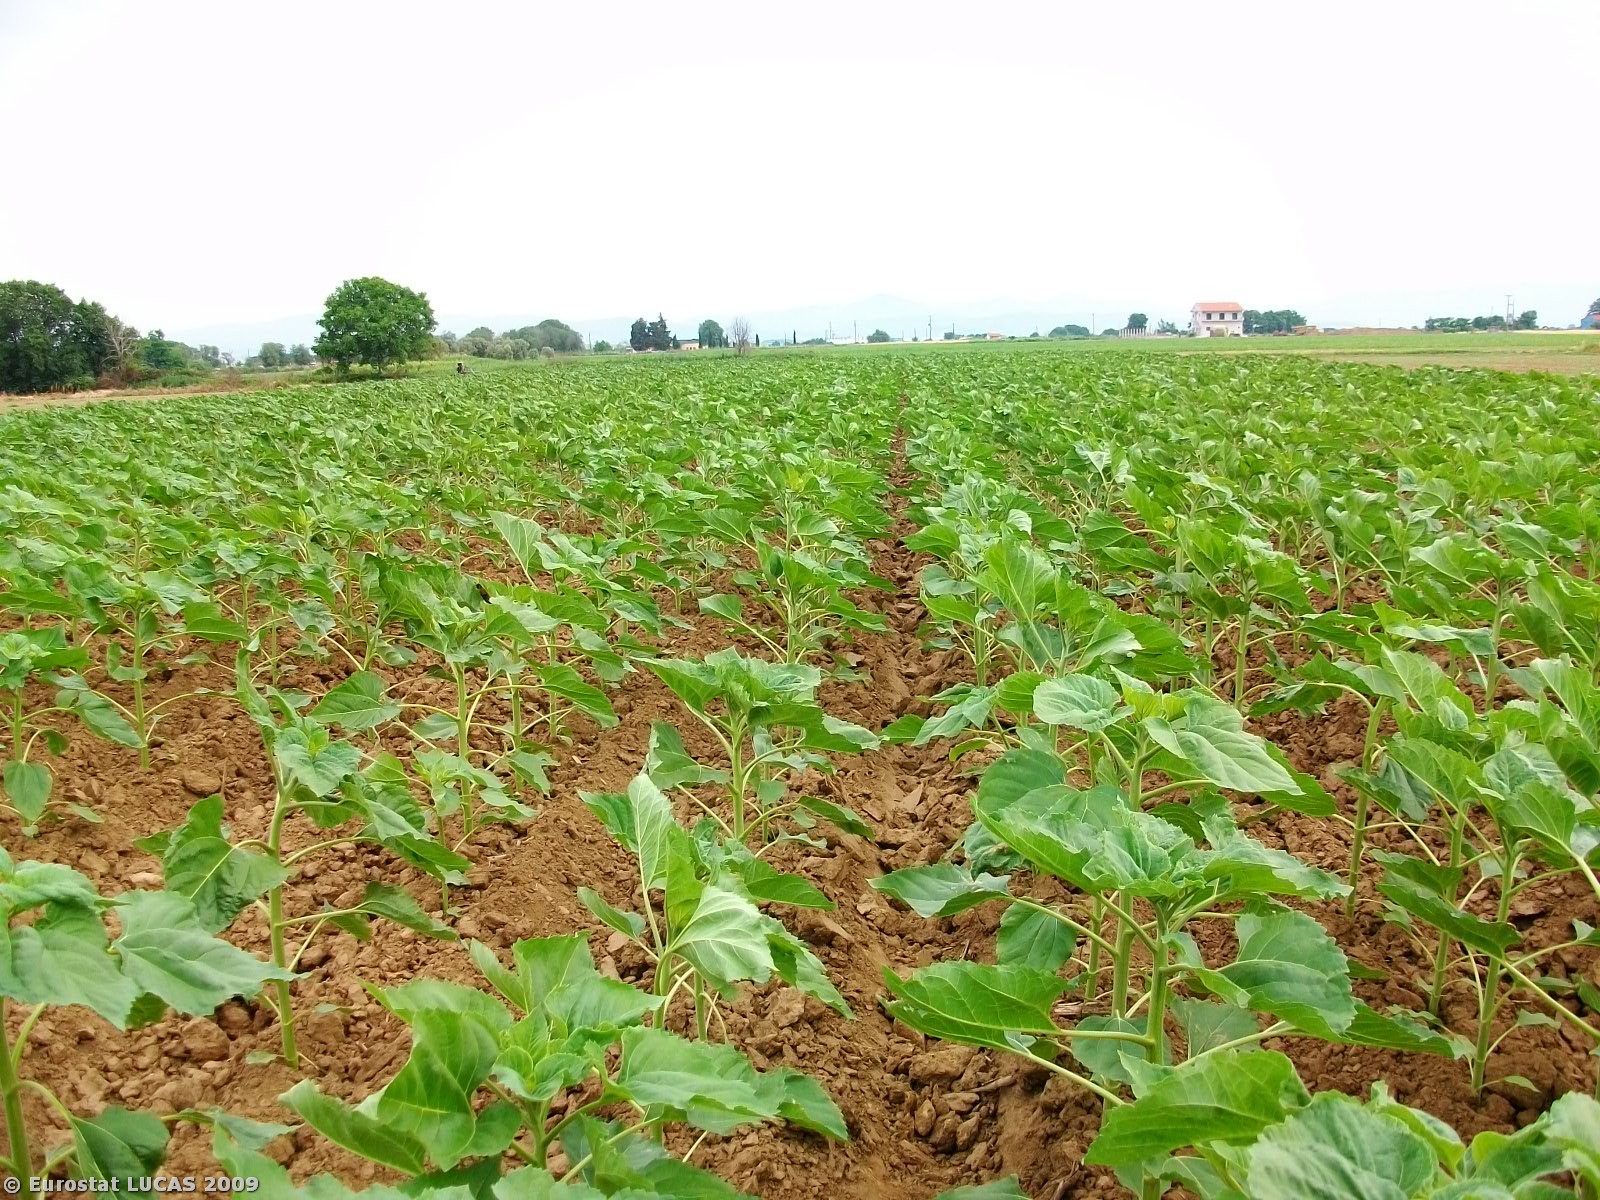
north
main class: Cropland
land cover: Sunflower
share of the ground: > 75 %
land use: Agriculture (excluding fallow land and kitchen gardens)
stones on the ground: < 10 %
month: June
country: GR
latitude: 41.0476
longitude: 25.5058
